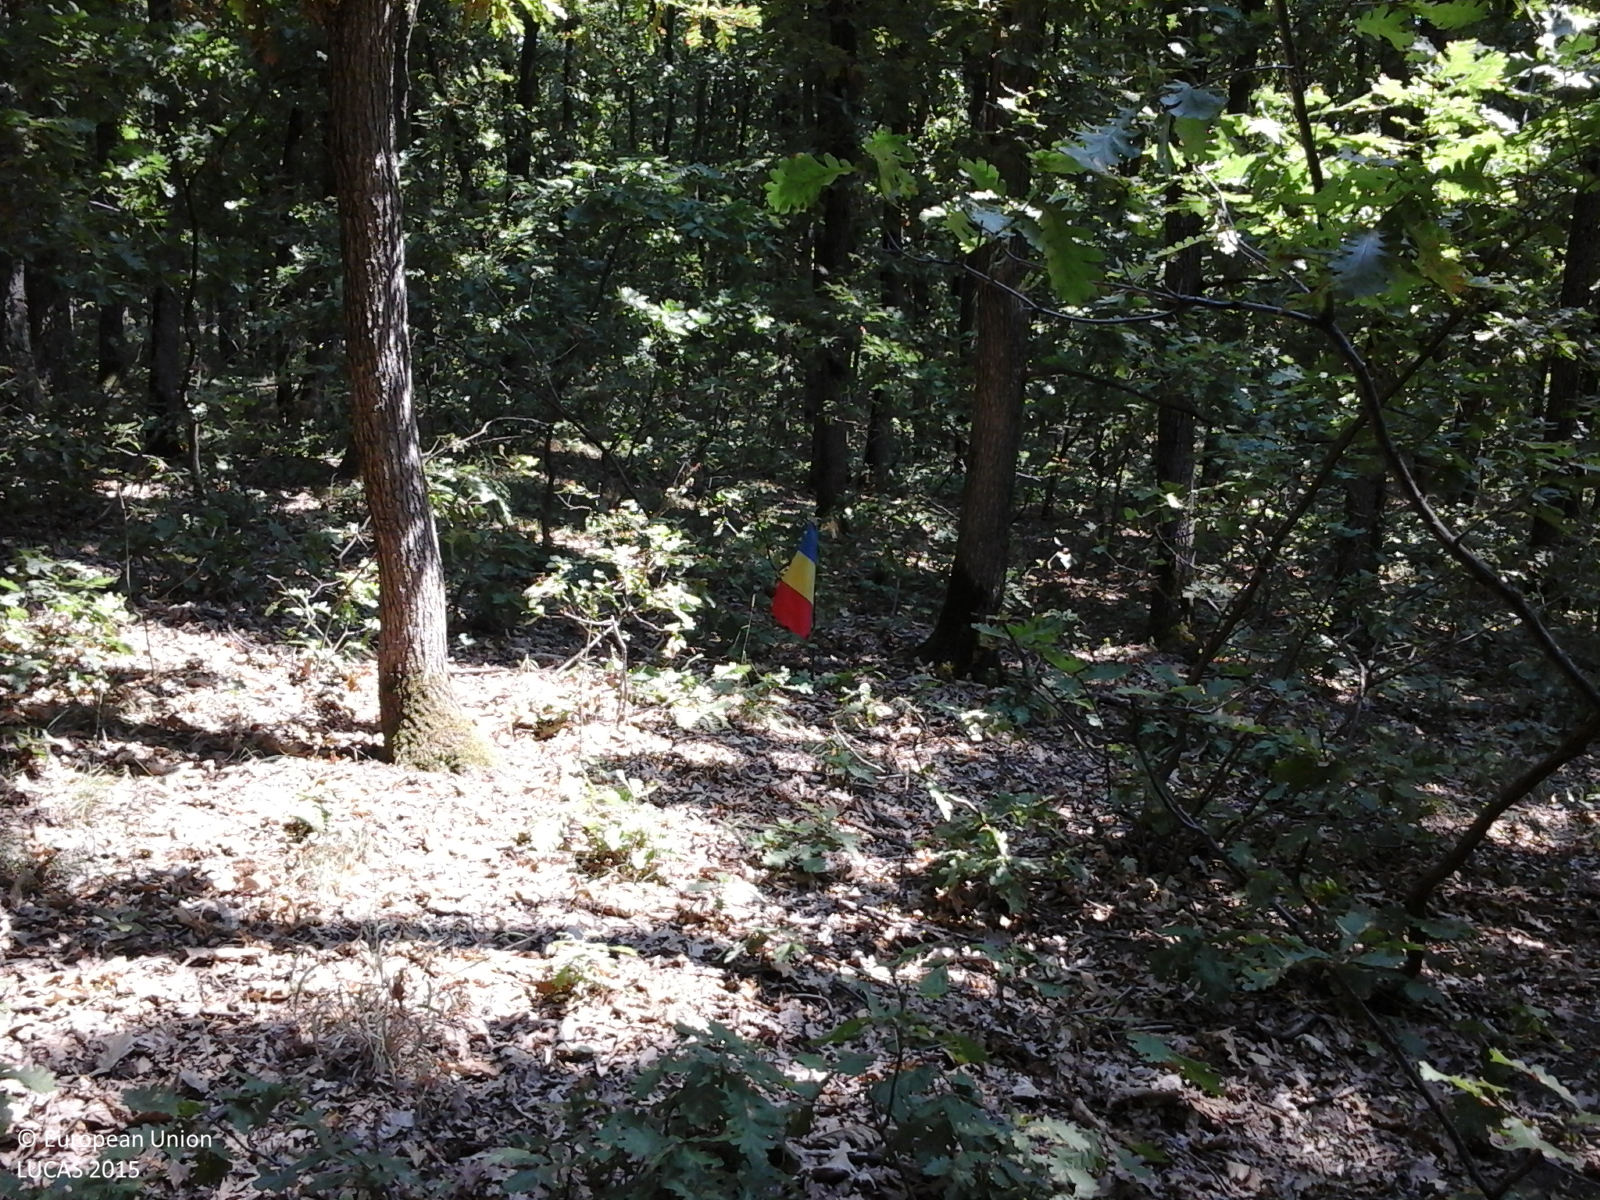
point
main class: Woodland
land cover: Broadleaved woodland
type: acidophilous oak and oak-birch forest
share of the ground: > 75 %
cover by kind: broadleaved forest trees 100 %
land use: Forestry
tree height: > 5 m
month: August
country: RO
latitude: 44.5082
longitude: 23.4745
